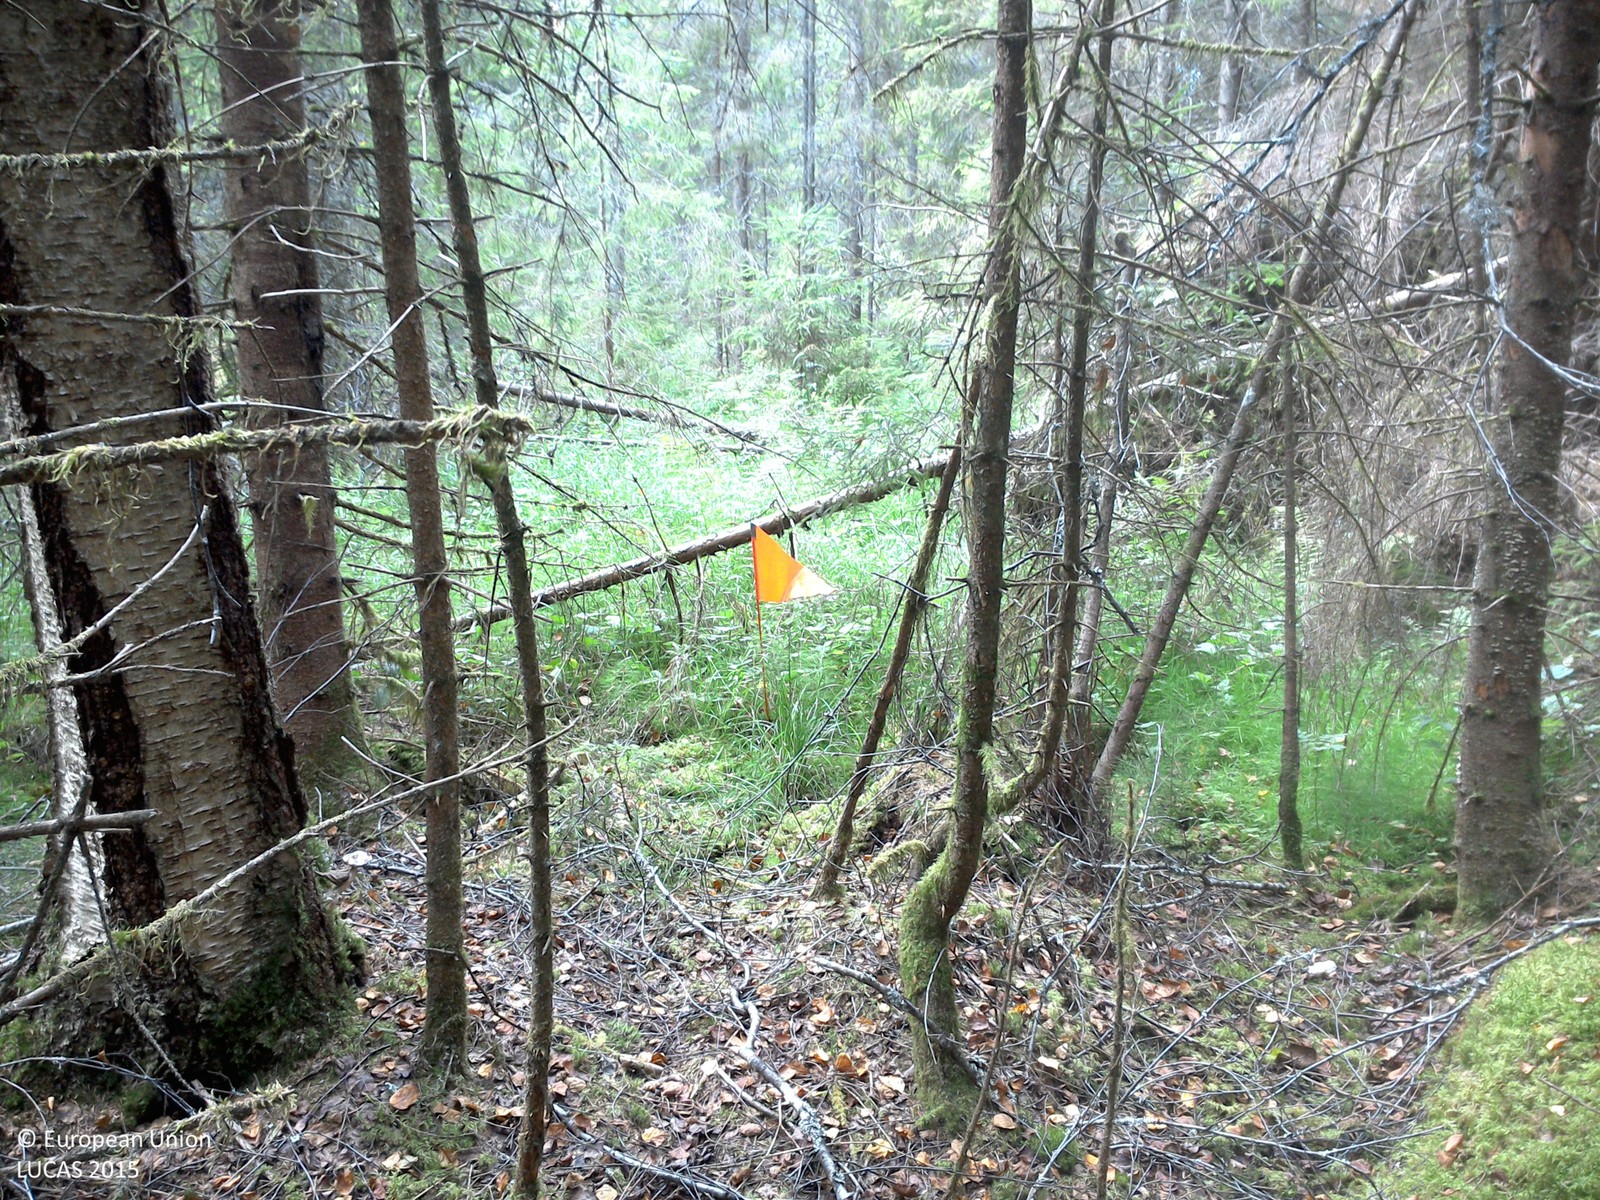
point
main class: Woodland
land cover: Spruce dominated coniferous woodland
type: boreal forest
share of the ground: 50 - 75 %
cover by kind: coniferous forest trees 70 %, herbaceous plants 20 %, lichens and mosses 10 %
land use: Forestry
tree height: > 5 m
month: August
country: SE
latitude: 57.9081
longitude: 15.5143
